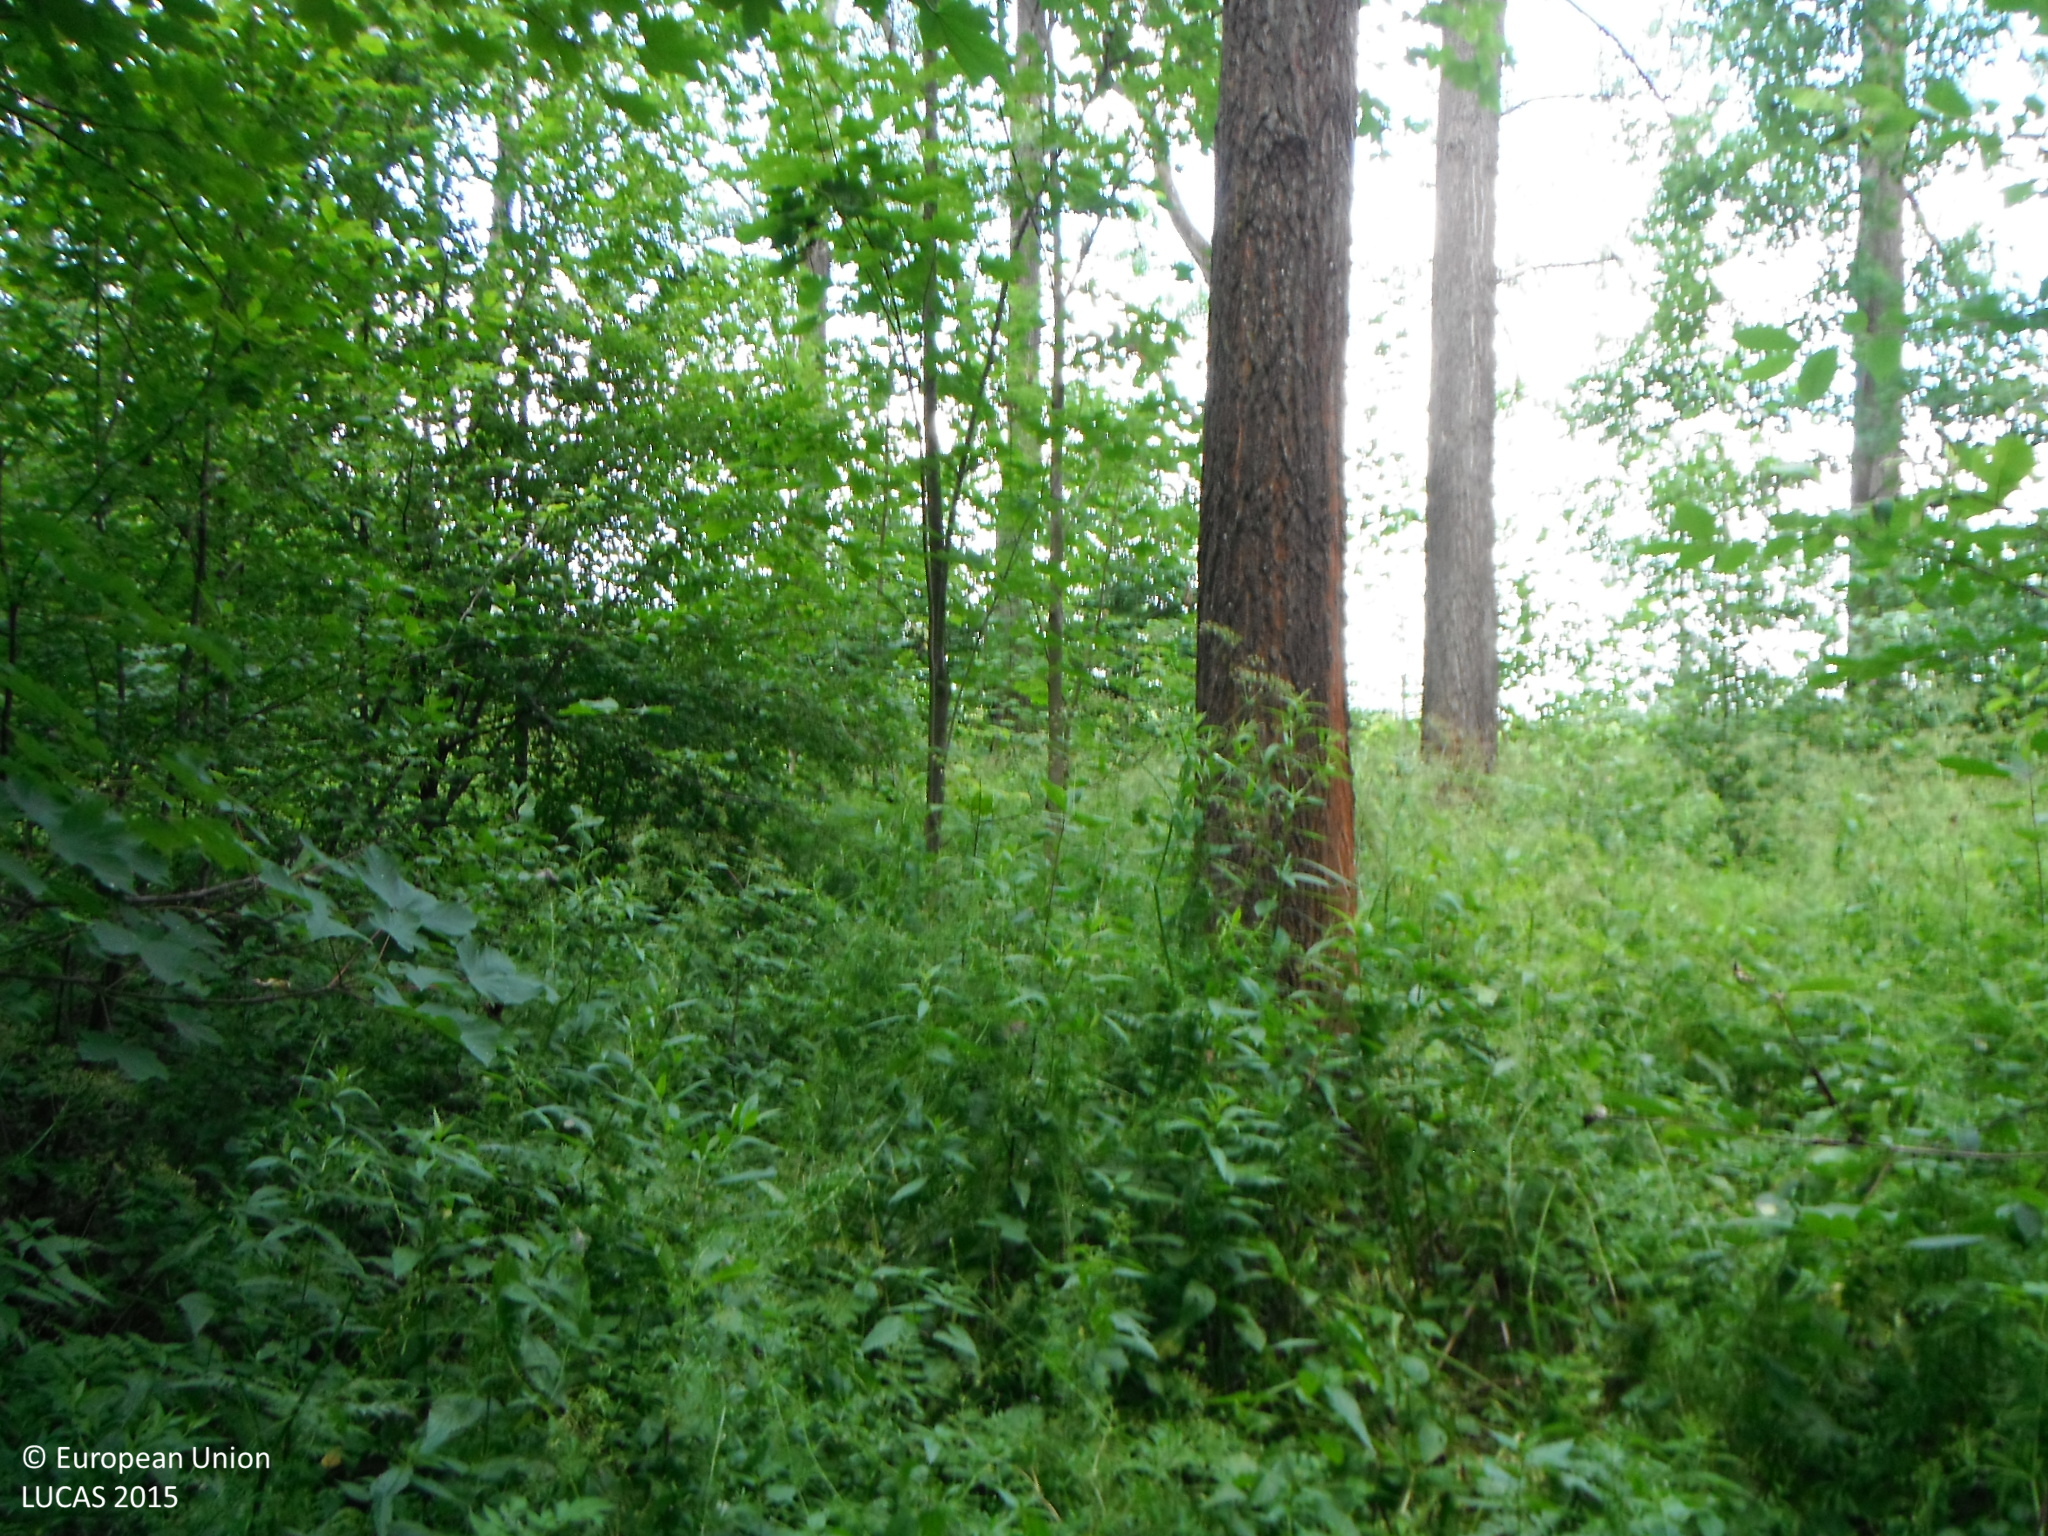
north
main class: Woodland
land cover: Broadleaved woodland
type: floodplain forest
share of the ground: > 75 %
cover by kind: broadleaved forest trees 75 %, herbaceous plants 25 %
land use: Forestry
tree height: > 5 m
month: July
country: SK
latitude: 49.4224
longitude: 19.5254
